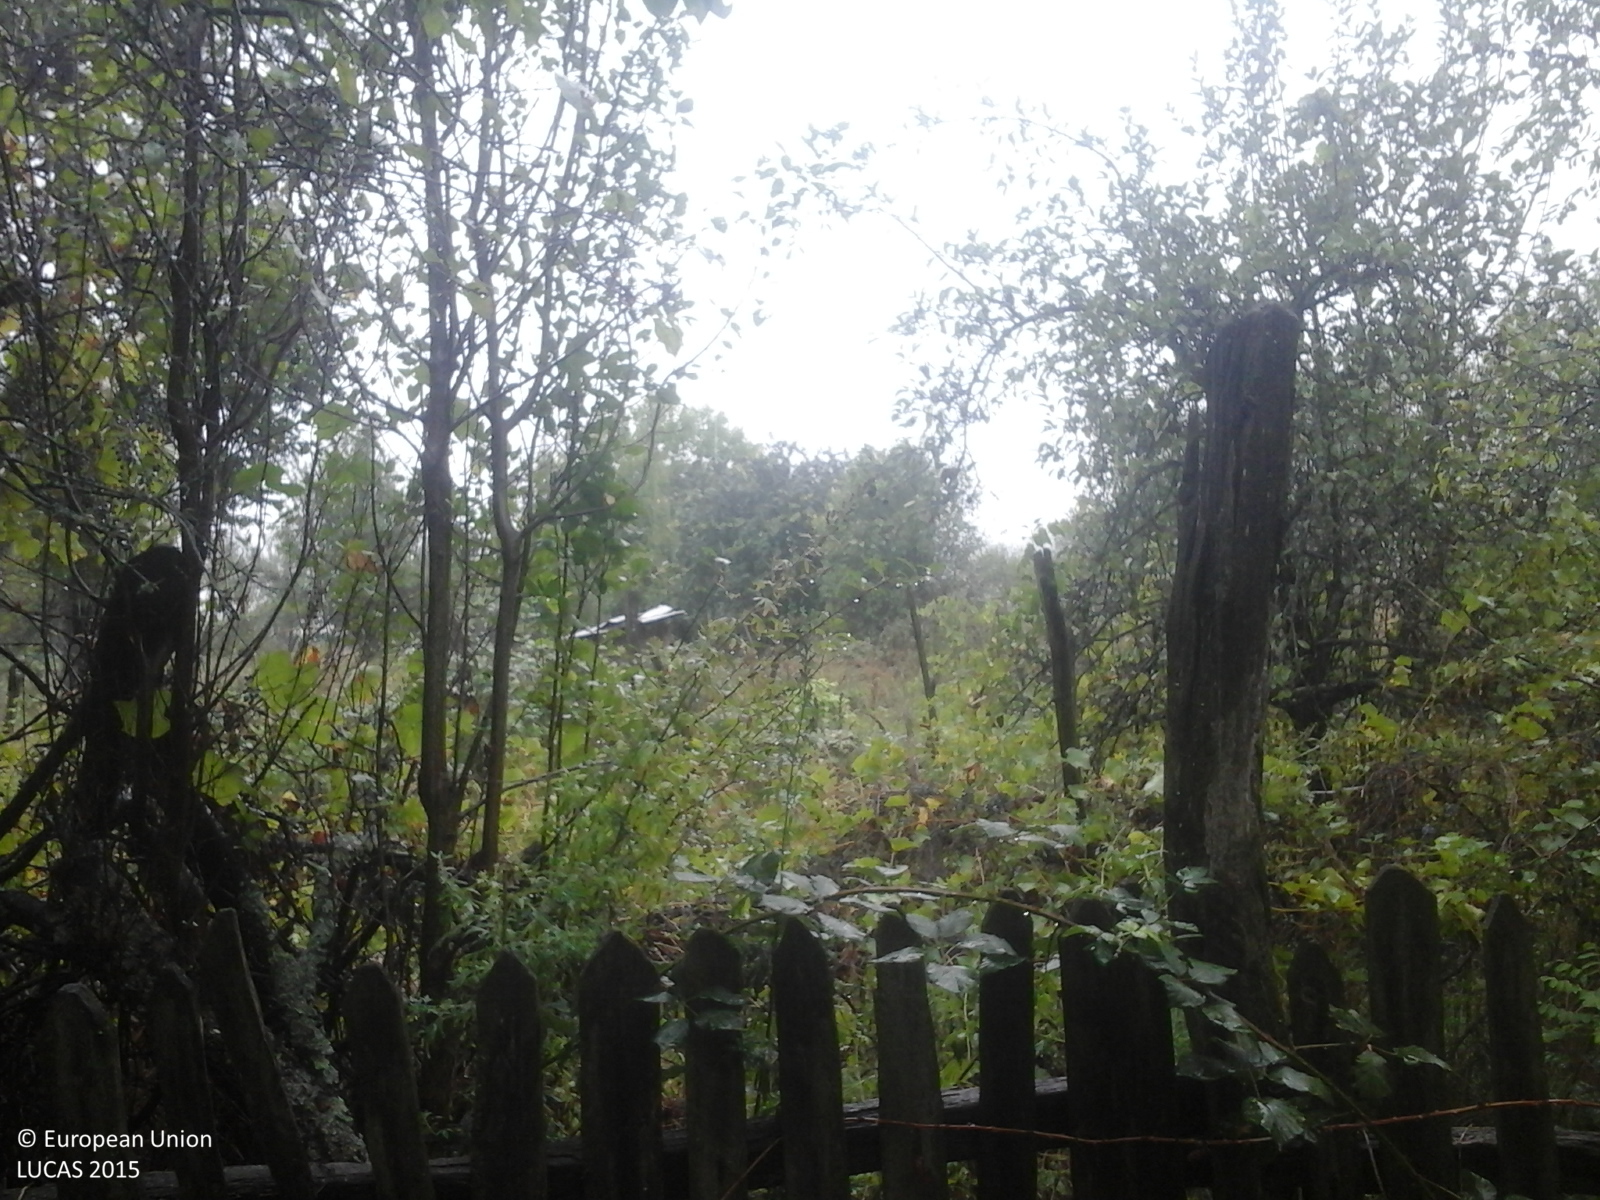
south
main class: Cropland
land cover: Vineyards
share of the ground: > 75 %
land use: Agriculture (excluding fallow land and kitchen gardens)
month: September
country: RO
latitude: 44.8332
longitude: 23.5022
